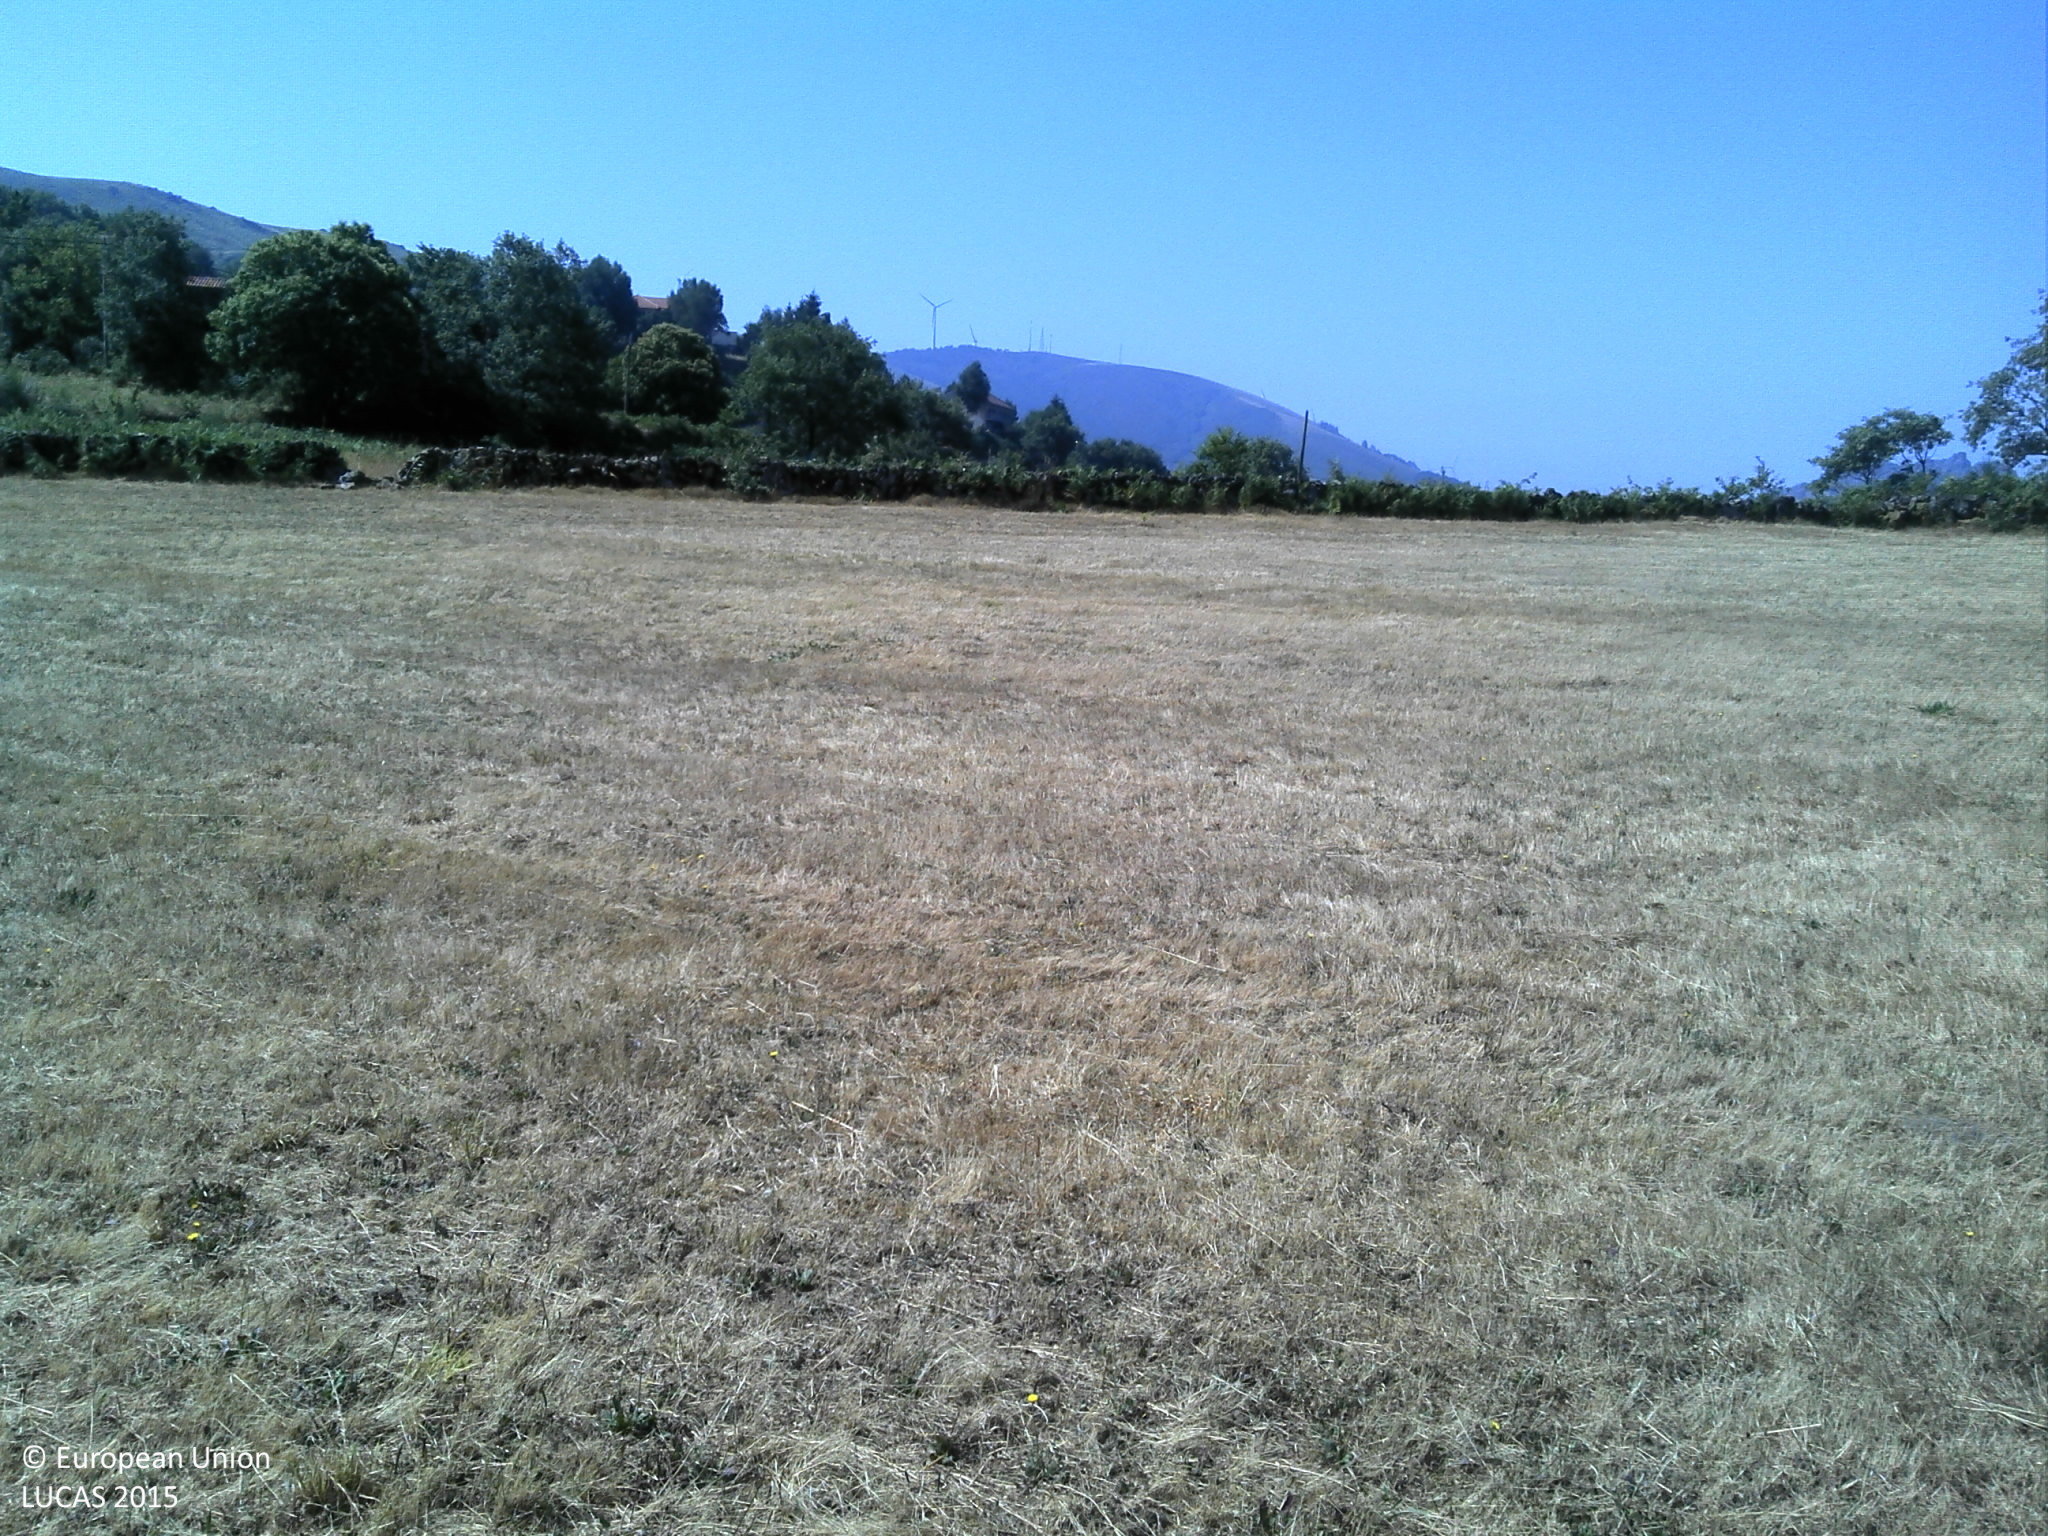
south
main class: Grassland
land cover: Grassland without tree/shrub cover
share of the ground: > 75 %
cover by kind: herbaceous plants 90 %, unconsolidated bare surface 10 %
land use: Agriculture (excluding fallow land and kitchen gardens)
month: July
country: PT
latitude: 41.7755
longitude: -7.9367
